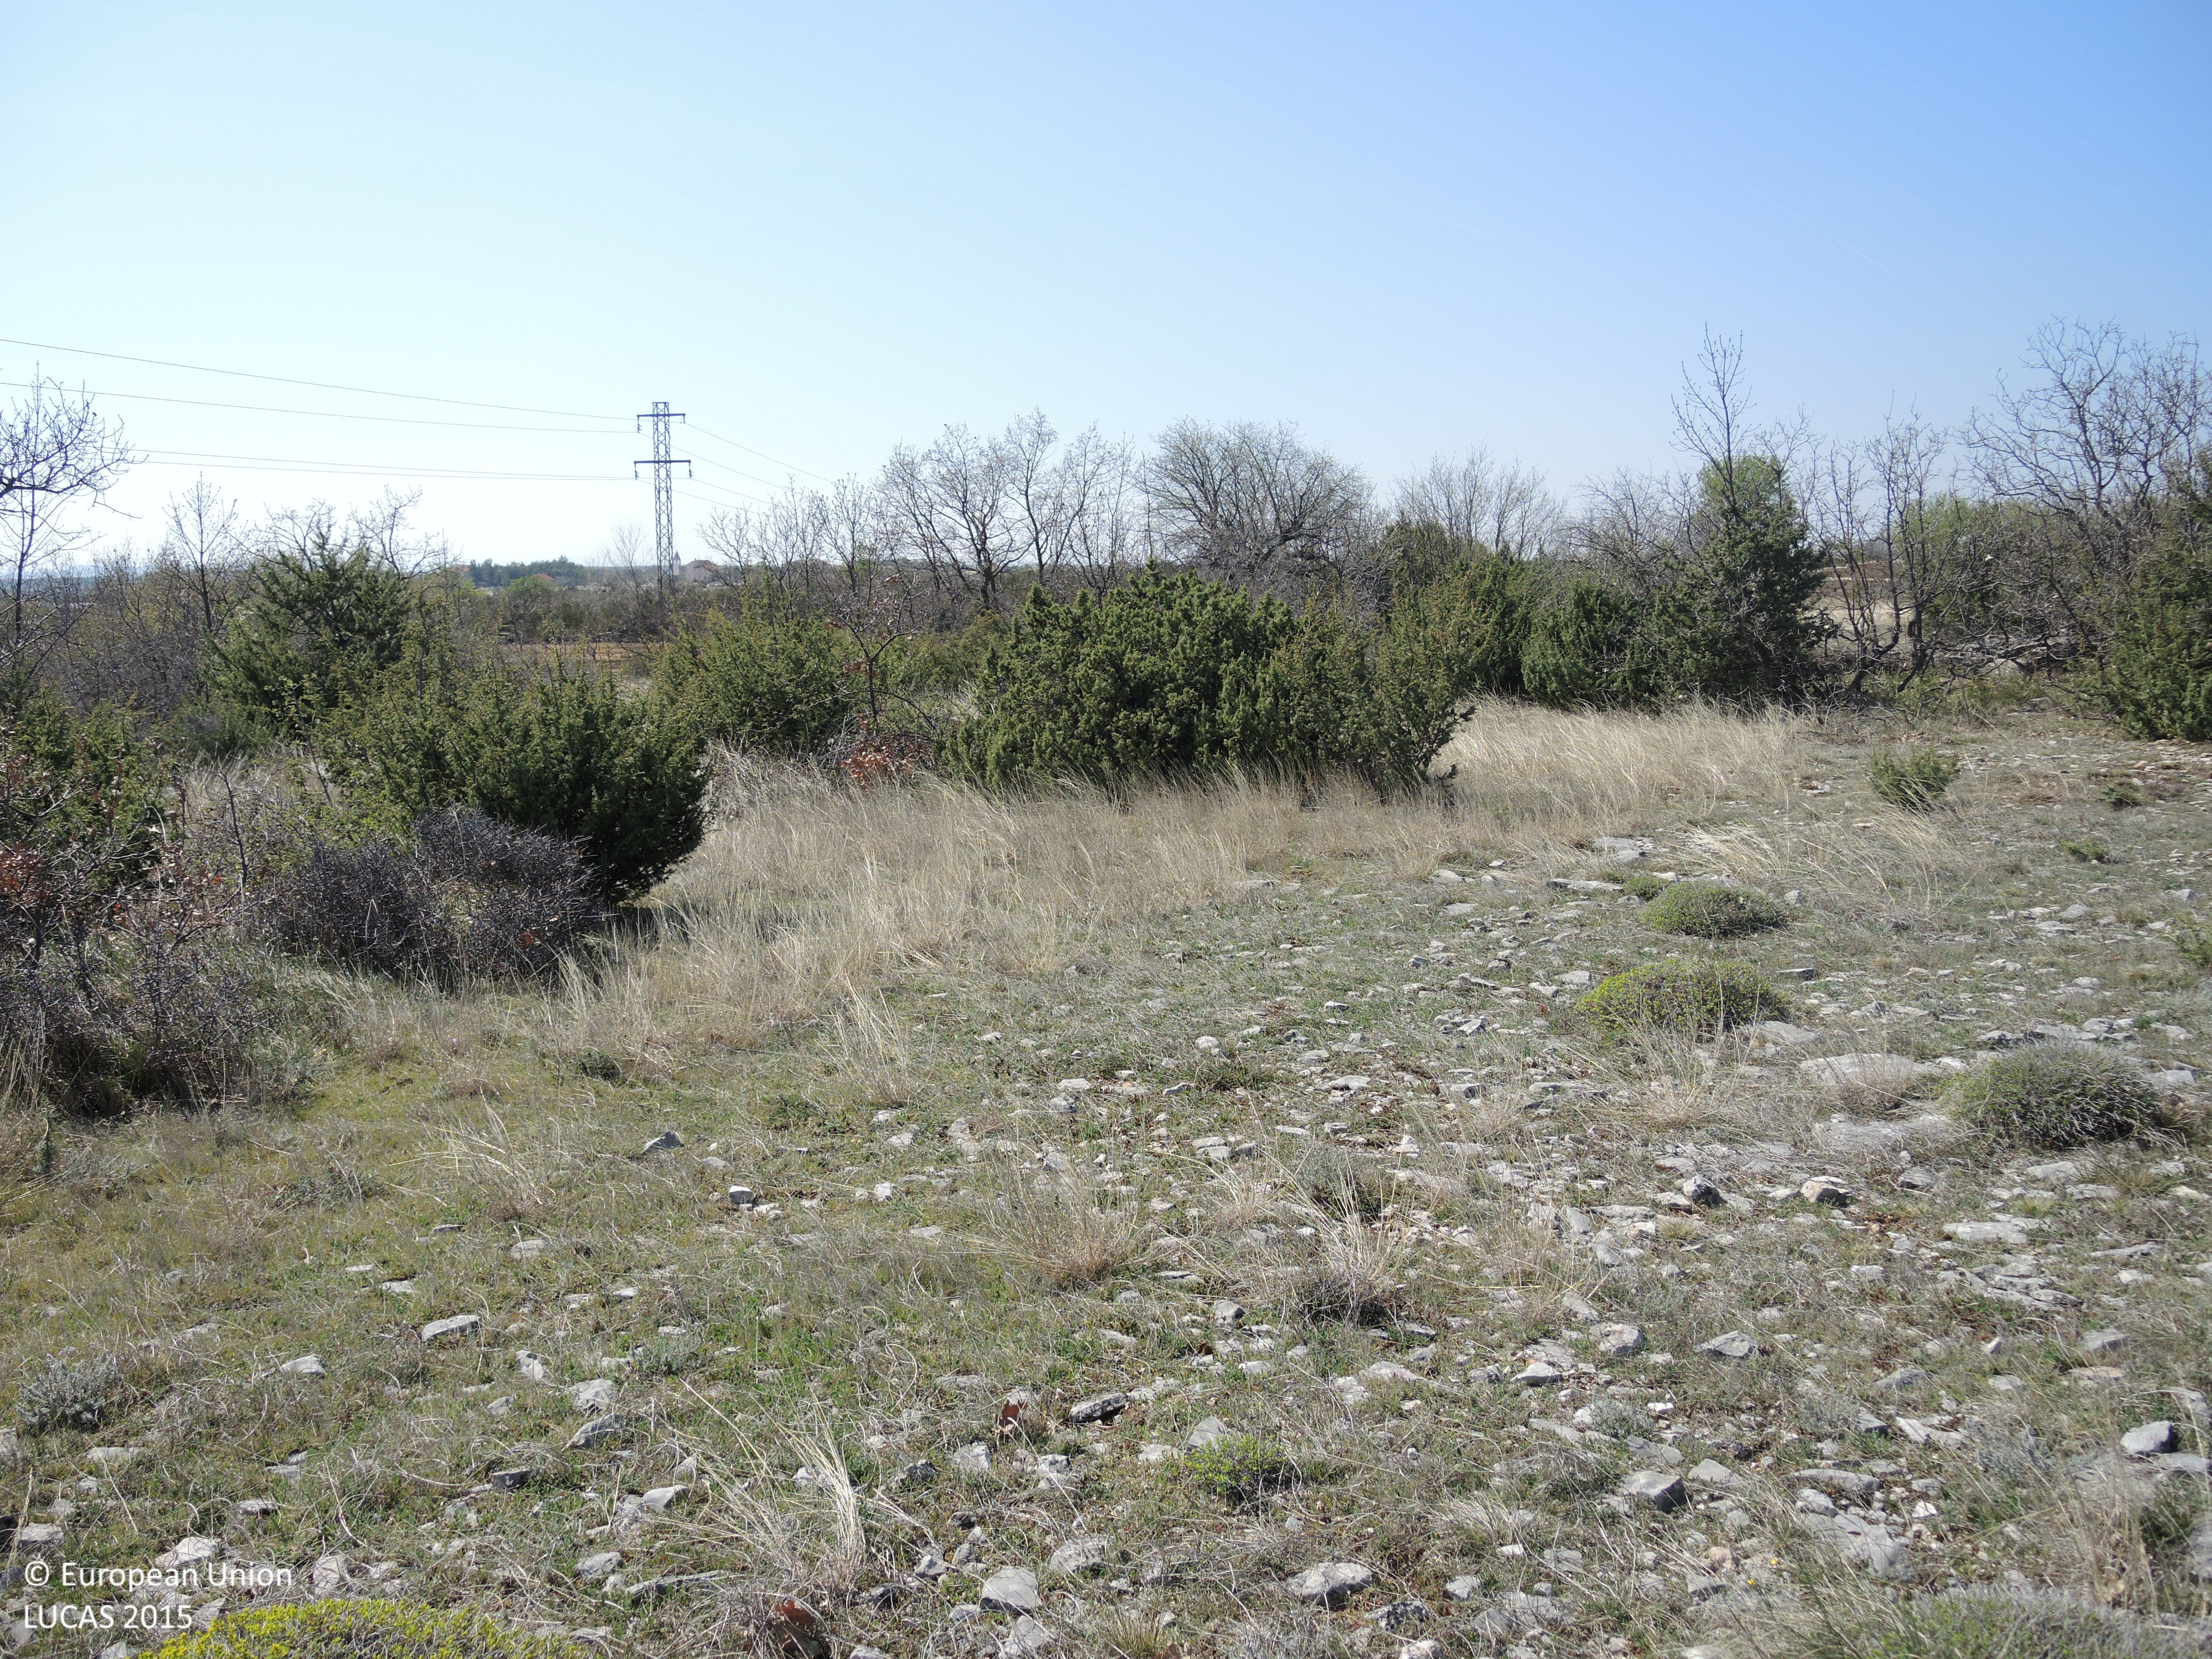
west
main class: Shrubland
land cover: Shrubland without tree cover
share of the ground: 10 - 25 %
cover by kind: herbaceous plants 60 %, unconsolidated bare surface 20 %, shrubs 15 %, consolidated bare surface 5 %
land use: Semi-natural and natural areas not in use
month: April
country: HR
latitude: 44.0315
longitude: 15.6942
